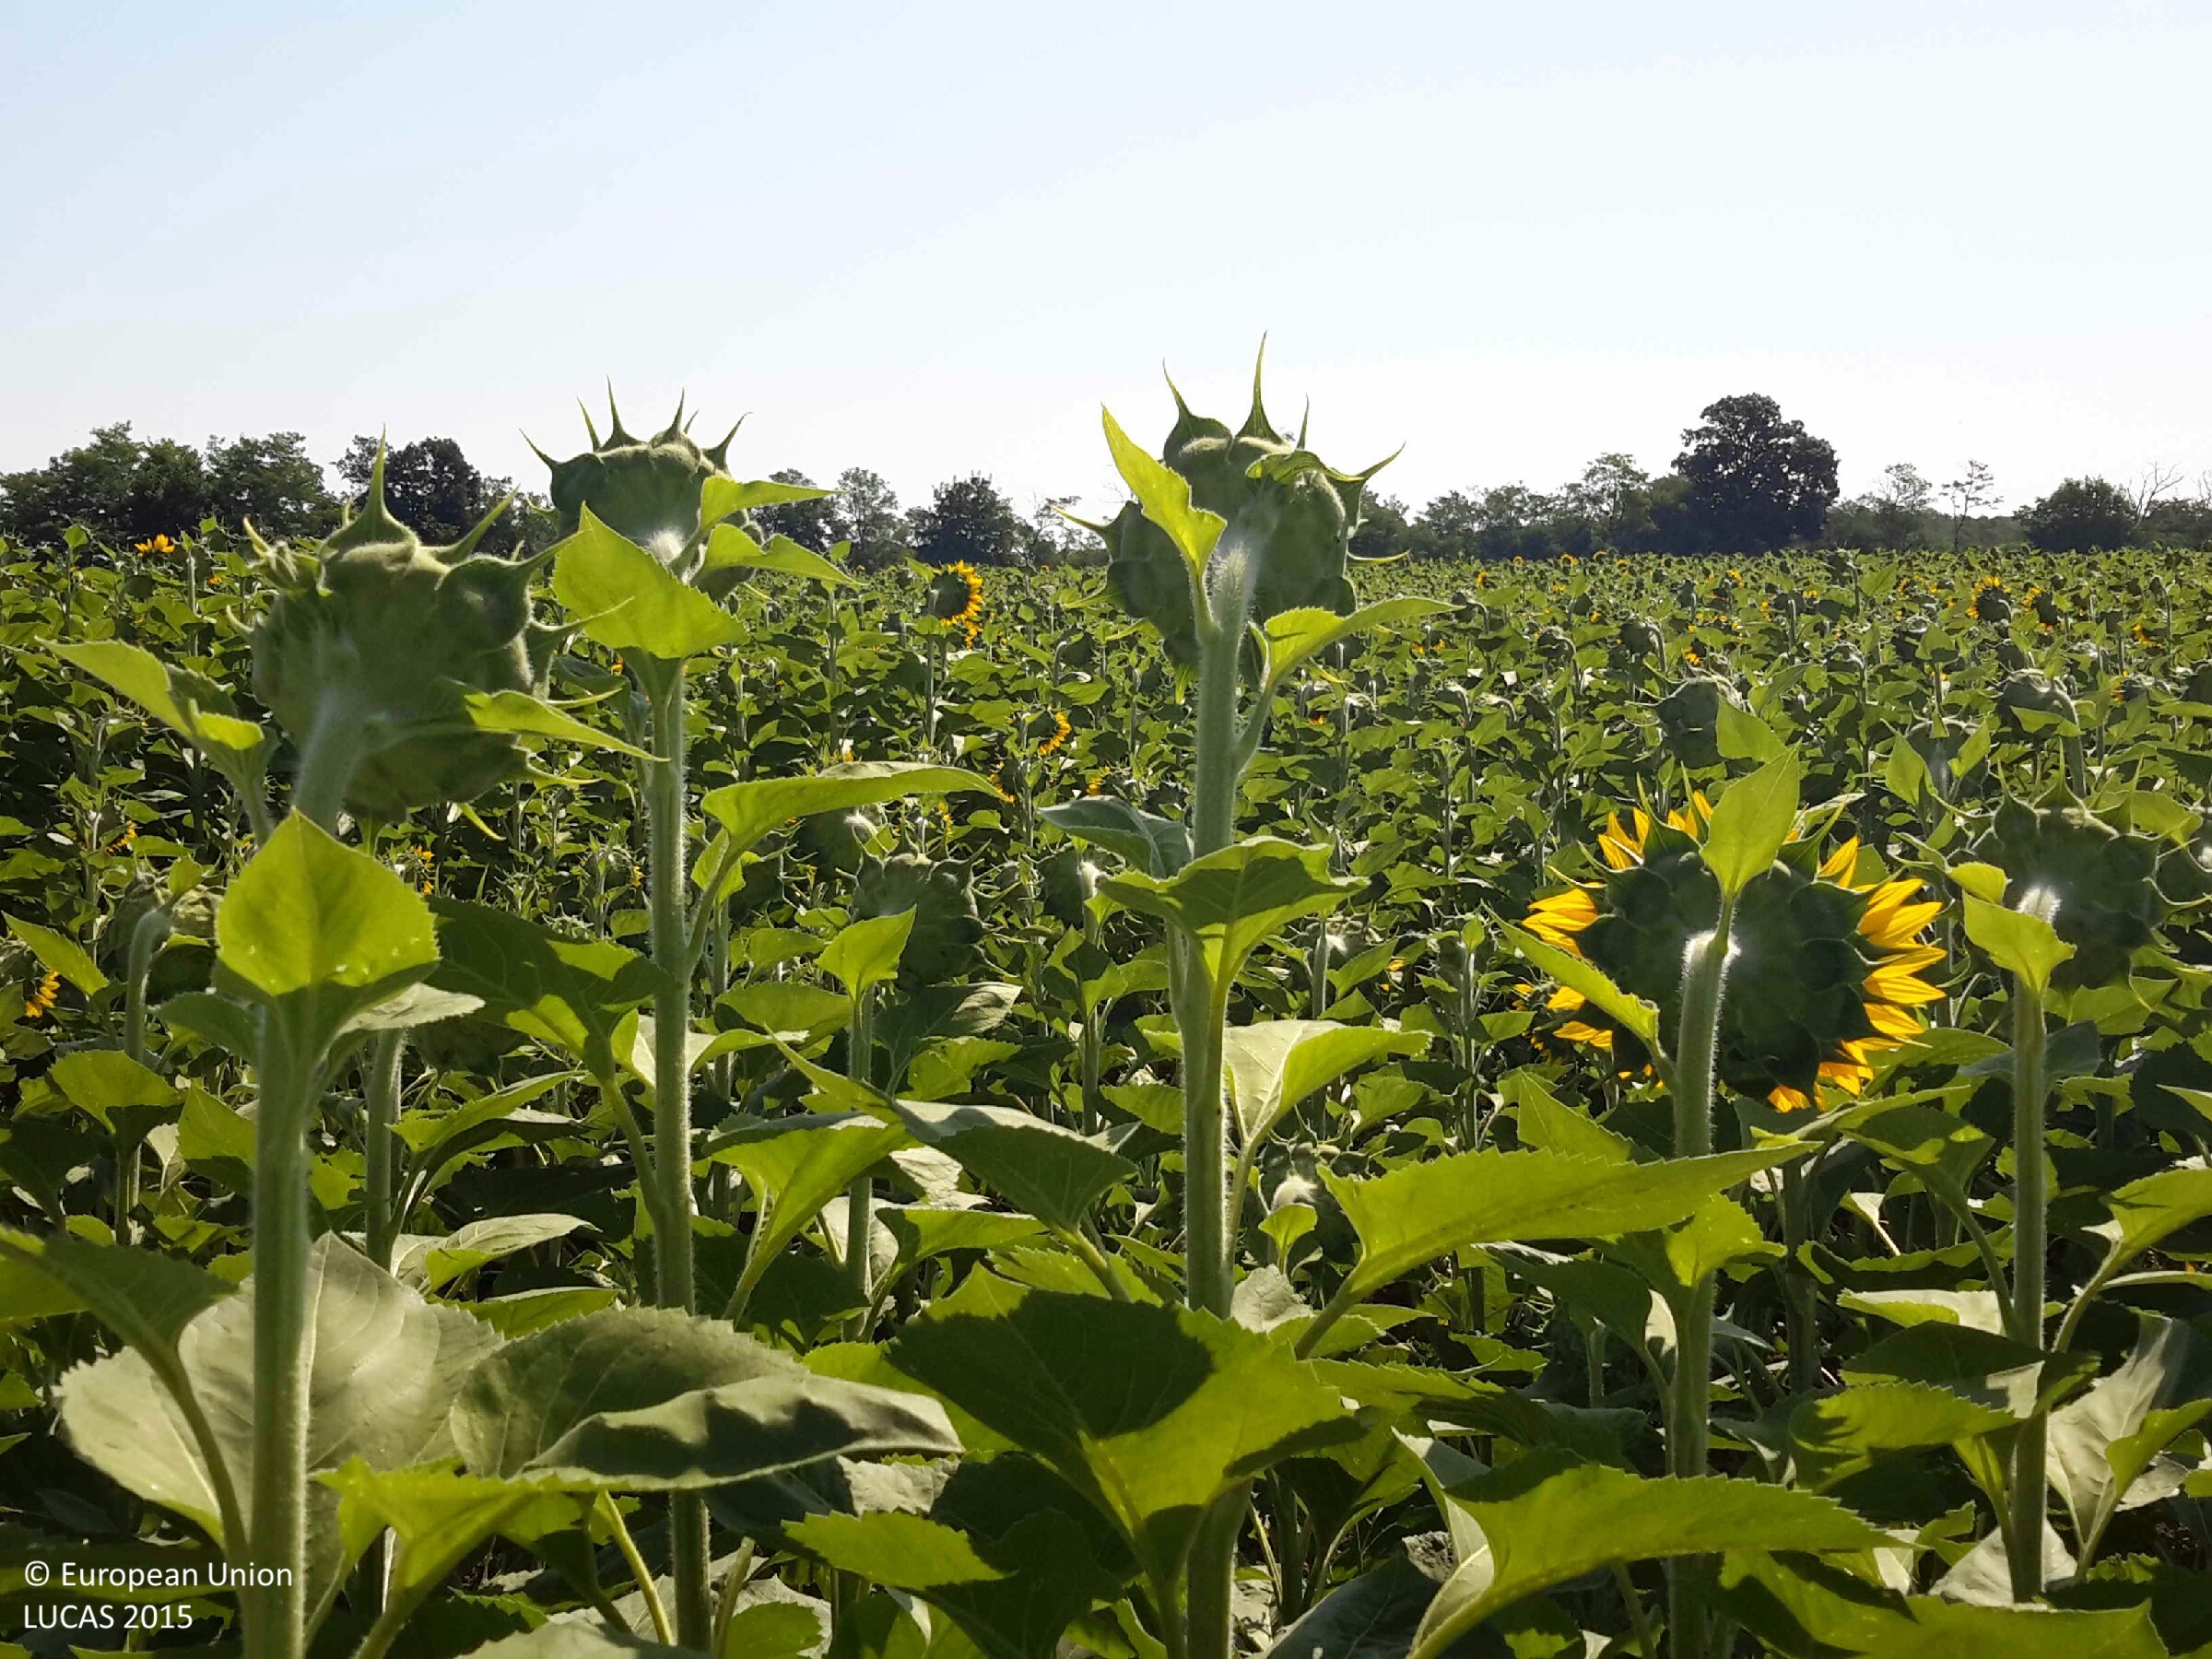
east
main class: Cropland
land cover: Sunflower
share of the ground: > 75 %
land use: Agriculture (excluding fallow land and kitchen gardens)
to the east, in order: Sunflower; Grass margins; Tracks; Grass margins; Shrubland with sparse tree cover; Barley
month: July
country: HU
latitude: 47.4751
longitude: 17.8251
